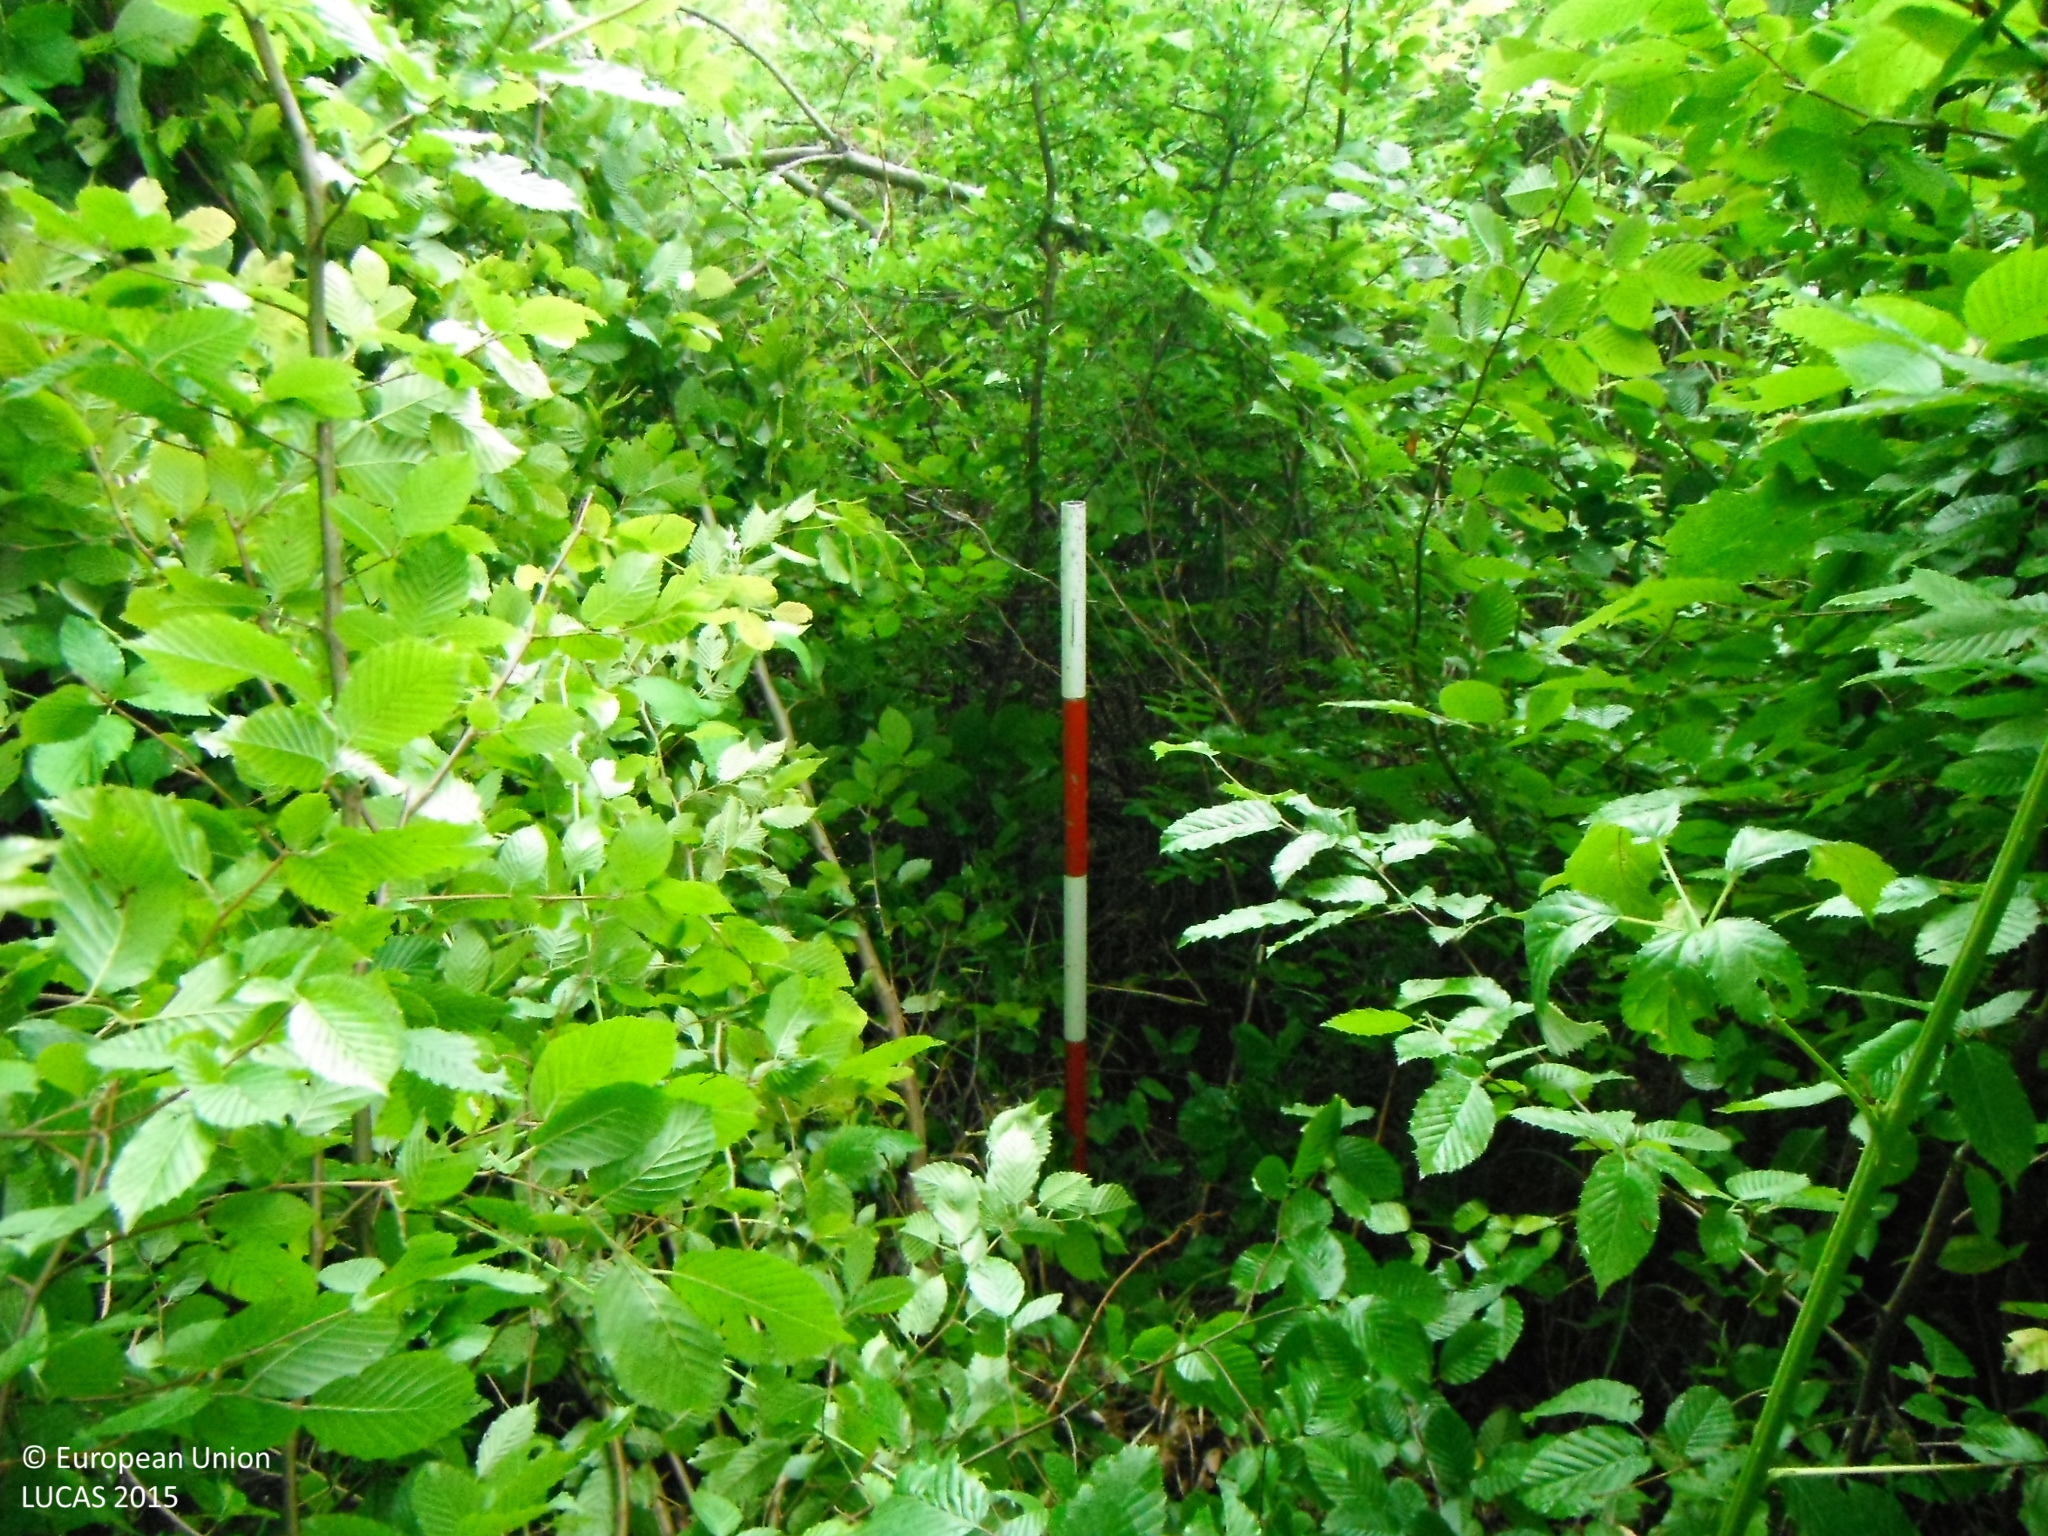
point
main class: Shrubland
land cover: Shrubland with sparse tree cover
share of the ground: > 75 %
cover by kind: shrubs 95 %, broadleaved forest trees 5 %
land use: Semi-natural and natural areas not in use
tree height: > 5 m
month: June
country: SK
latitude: 48.4522
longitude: 20.0490
